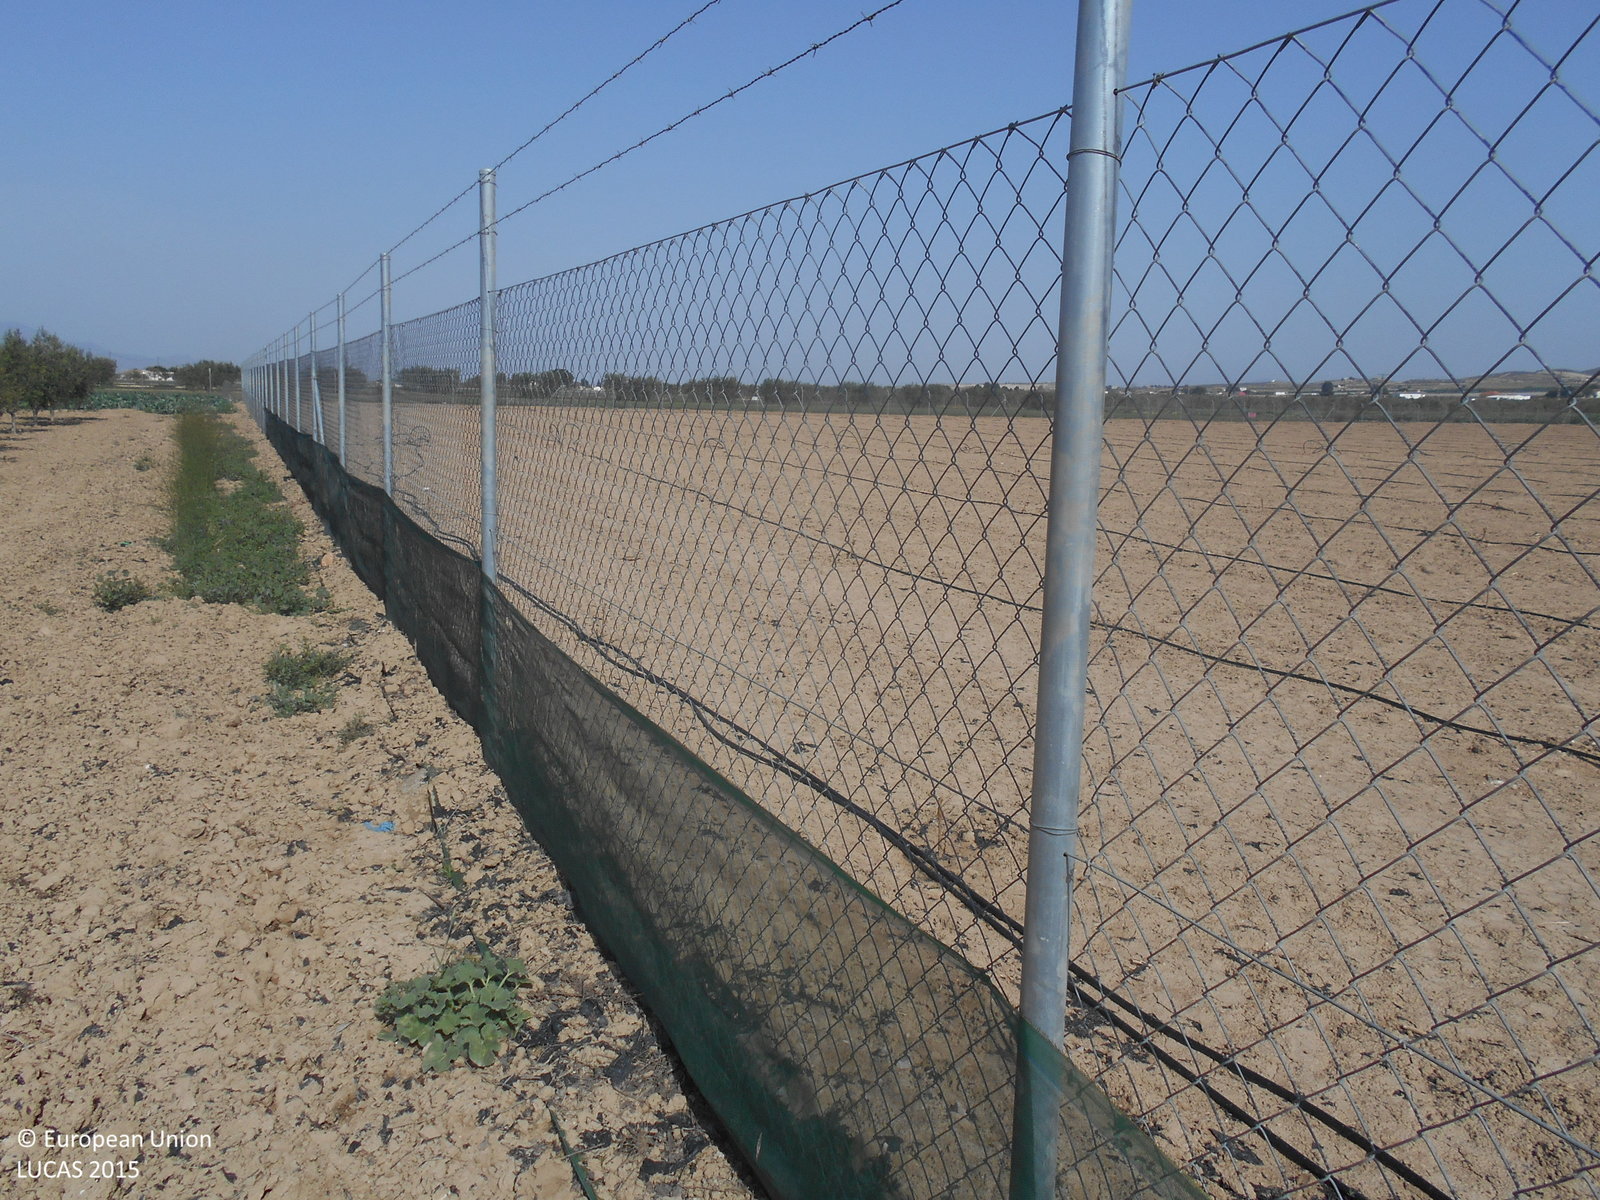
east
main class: Cropland
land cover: Vineyards
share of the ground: 25 - 50 %
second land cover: Other bare soil
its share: > 75 %
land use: Agriculture (excluding fallow land and kitchen gardens)
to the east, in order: Vineyards; Other bare soil; Fences; Ditches and canals; Durum wheat; Ditches and canals; Groves; Permanent crops (only in case pi); Olive groves
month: April
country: ES
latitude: 37.7041
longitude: -1.5174
